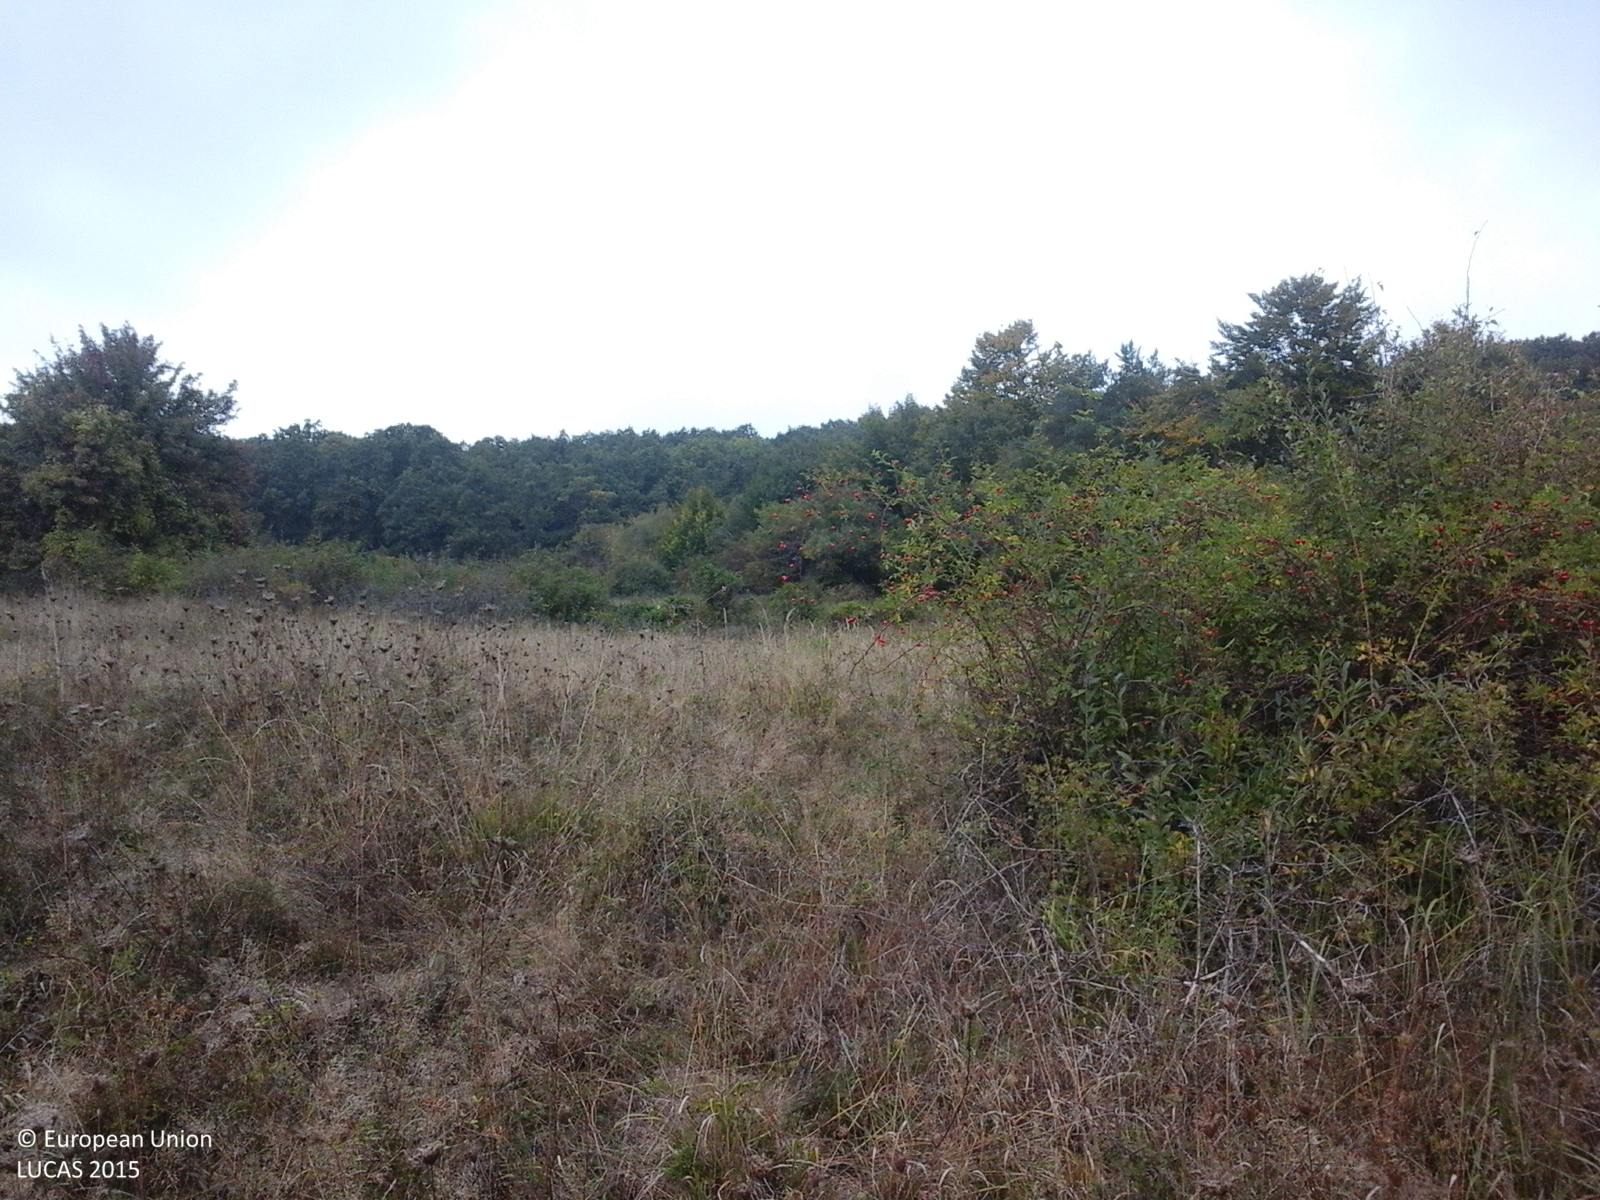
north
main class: Grassland
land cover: Grassland with sparse tree/shrub cover
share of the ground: > 75 %
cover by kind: herbaceous plants 85 %, shrubs 10 %, broadleaved forest trees 5 %
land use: Fallow land
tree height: < 5 m
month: October
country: RO
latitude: 46.0760
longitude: 25.1086
